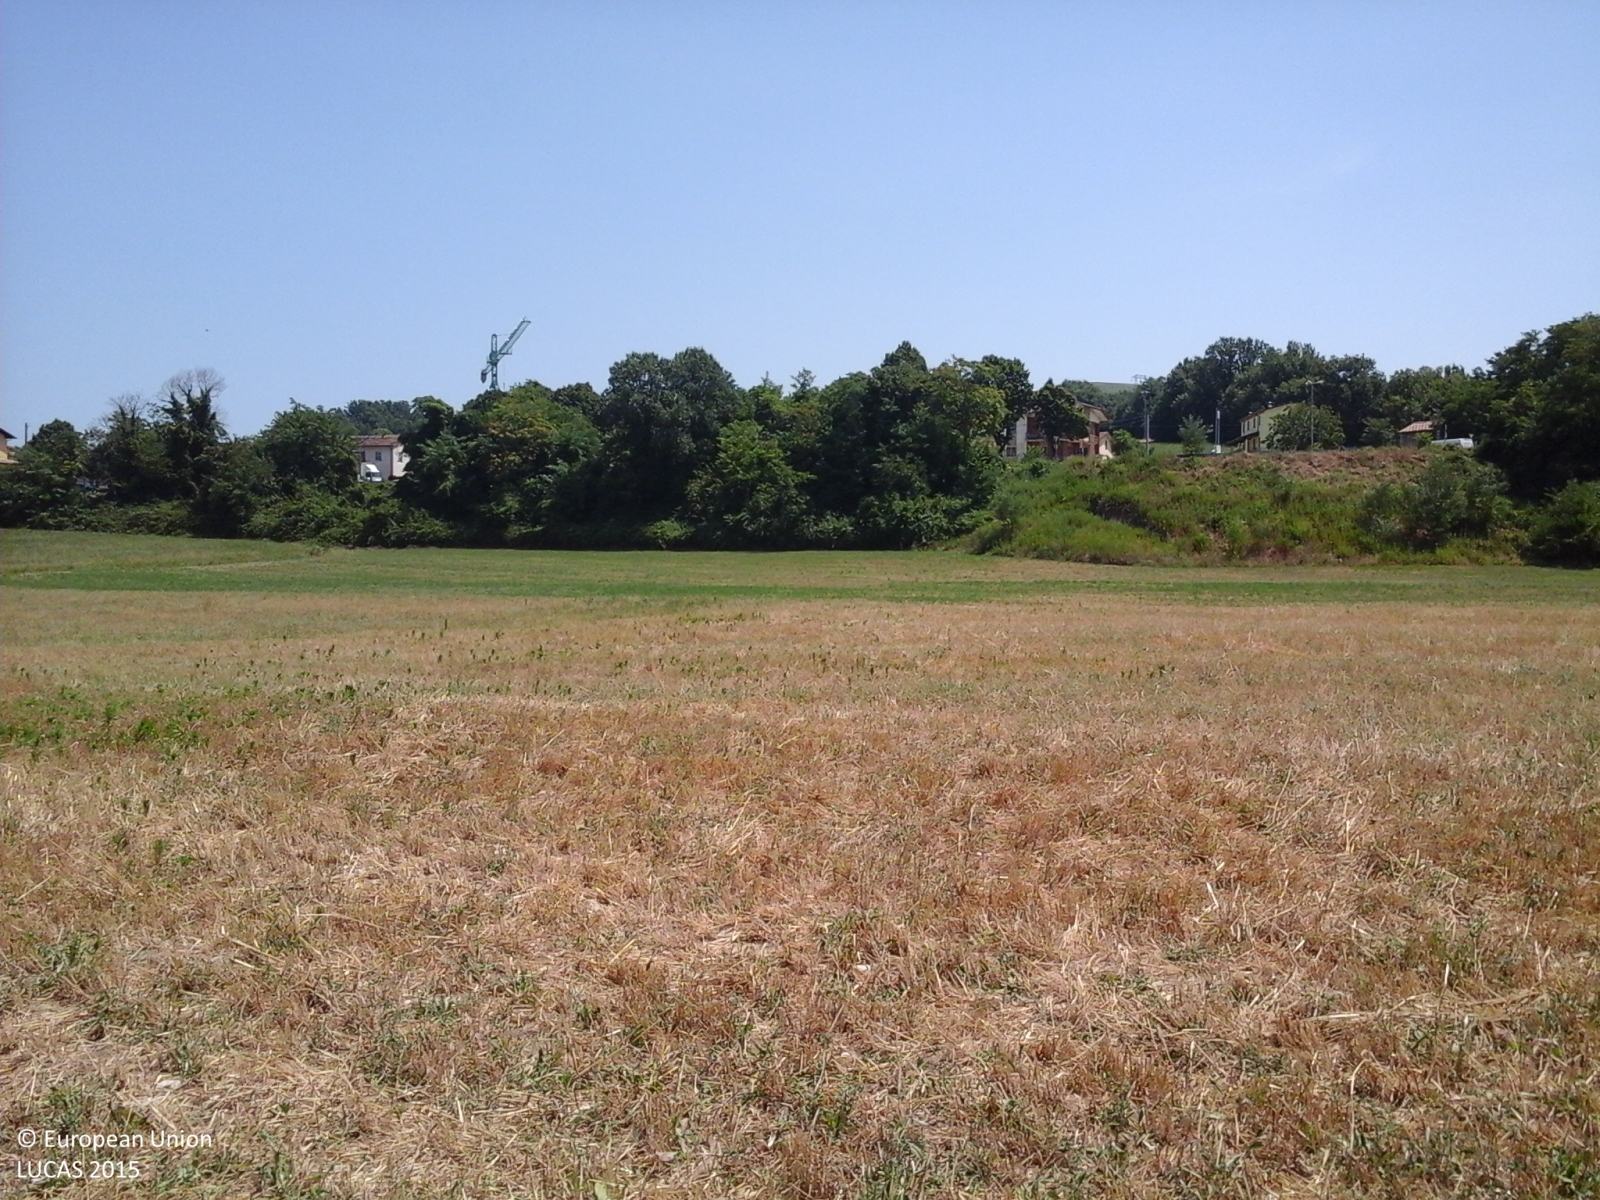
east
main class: Cropland
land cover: Barley
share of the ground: > 75 %
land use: Agriculture (excluding fallow land and kitchen gardens)
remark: Harvested field
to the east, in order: Barley; Lucerne; Broadleaved woodland; Artificial constructions in urban areas
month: July
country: IT
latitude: 43.9619
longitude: 12.3997
